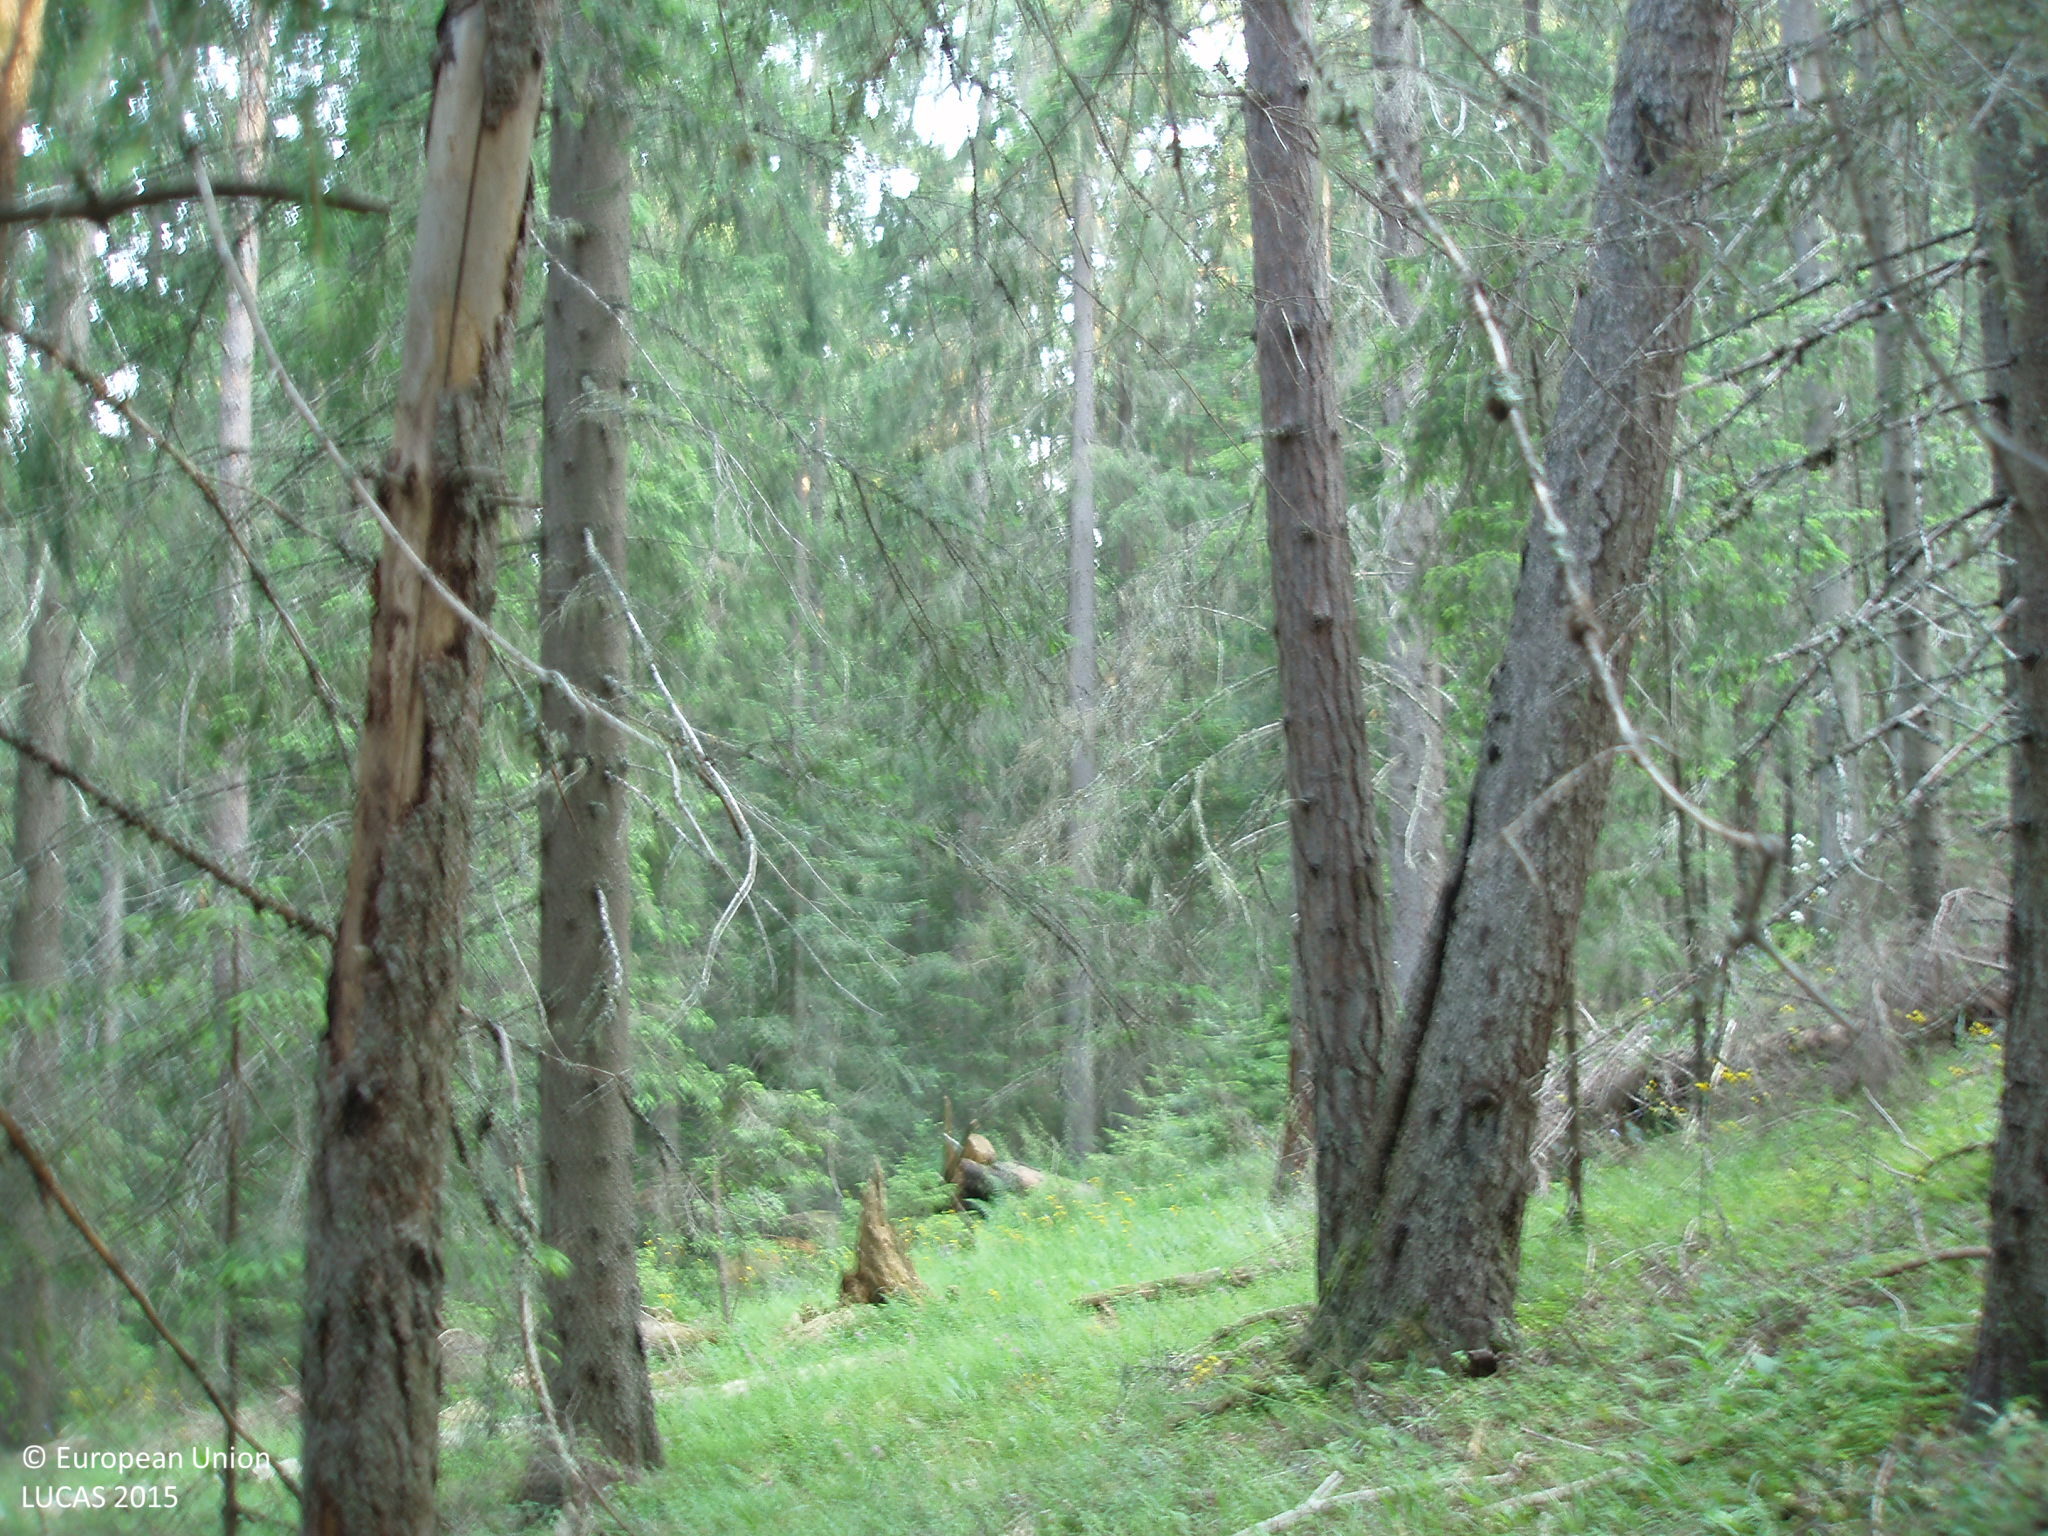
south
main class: Woodland
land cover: Spruce dominated coniferous woodland
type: hemiboreal forest and nemoral coniferous forest and mixed broadleaved-coniferous forest
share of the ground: > 75 %
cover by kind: coniferous forest trees 100 %
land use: Forestry
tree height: > 5 m
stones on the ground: 25 - 50 %
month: July
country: BG
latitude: 42.1010
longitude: 23.7098
